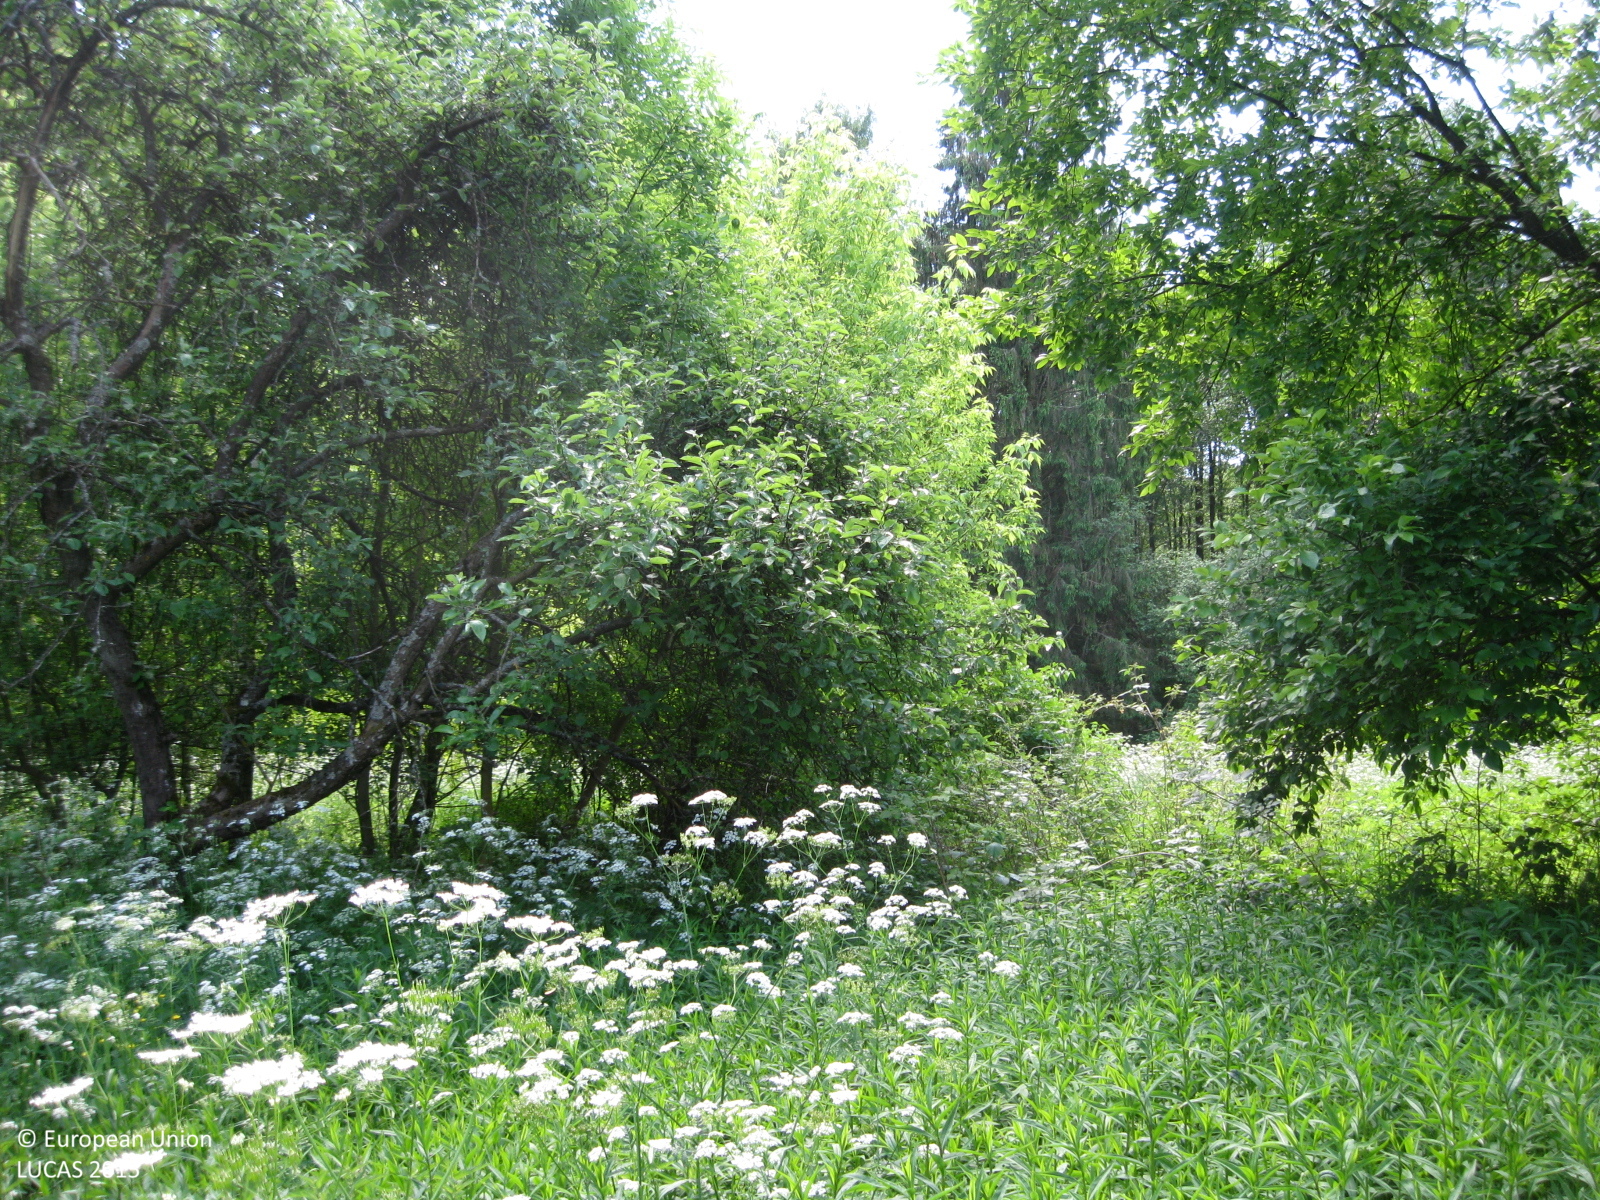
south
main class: Grassland
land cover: Spontaneously vegetated surfaces
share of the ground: > 75 %
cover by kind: herbaceous plants 100 %
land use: Semi-natural and natural areas not in use
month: June
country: LT
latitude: 55.3474
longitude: 23.9502
